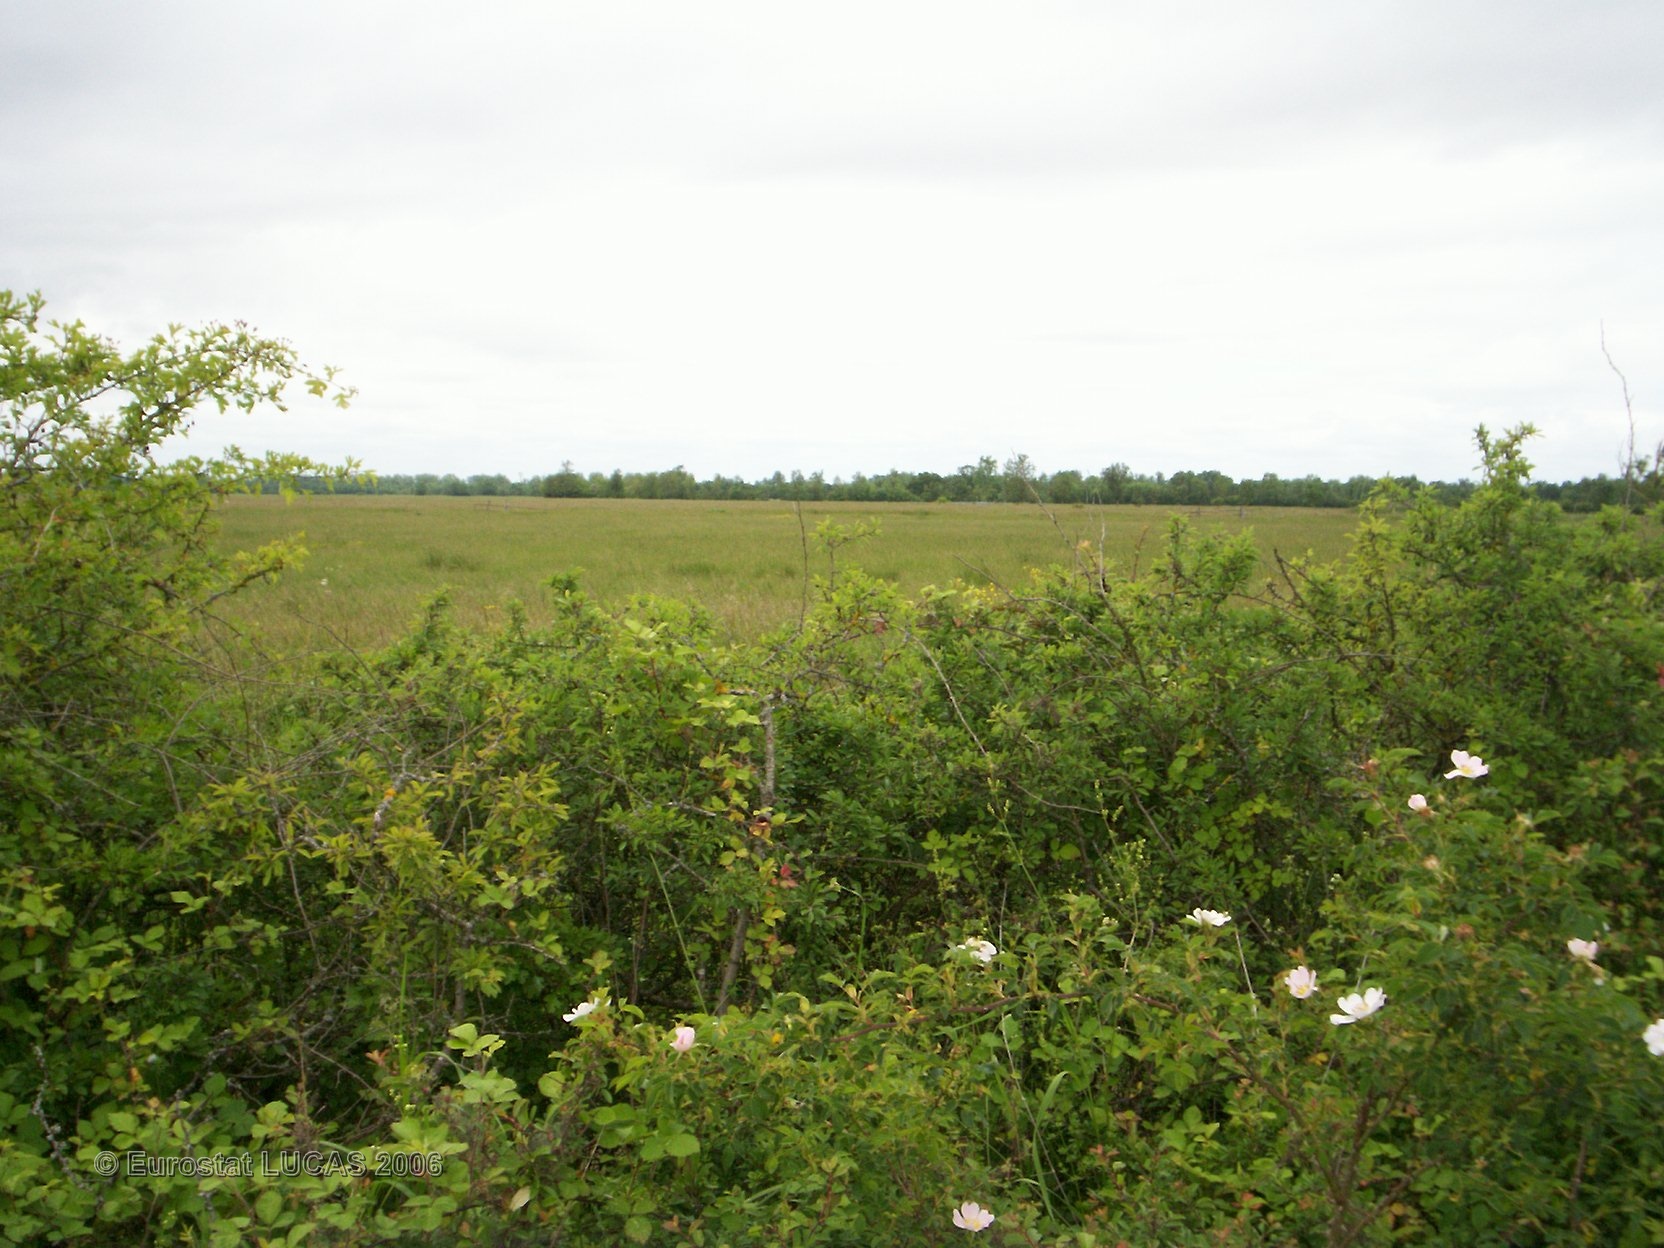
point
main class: Grassland
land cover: Grassland without tree/shrub cover
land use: Agriculture (excluding fallow land and kitchen gardens)
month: May
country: FR
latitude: 46.0293
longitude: -0.8934
